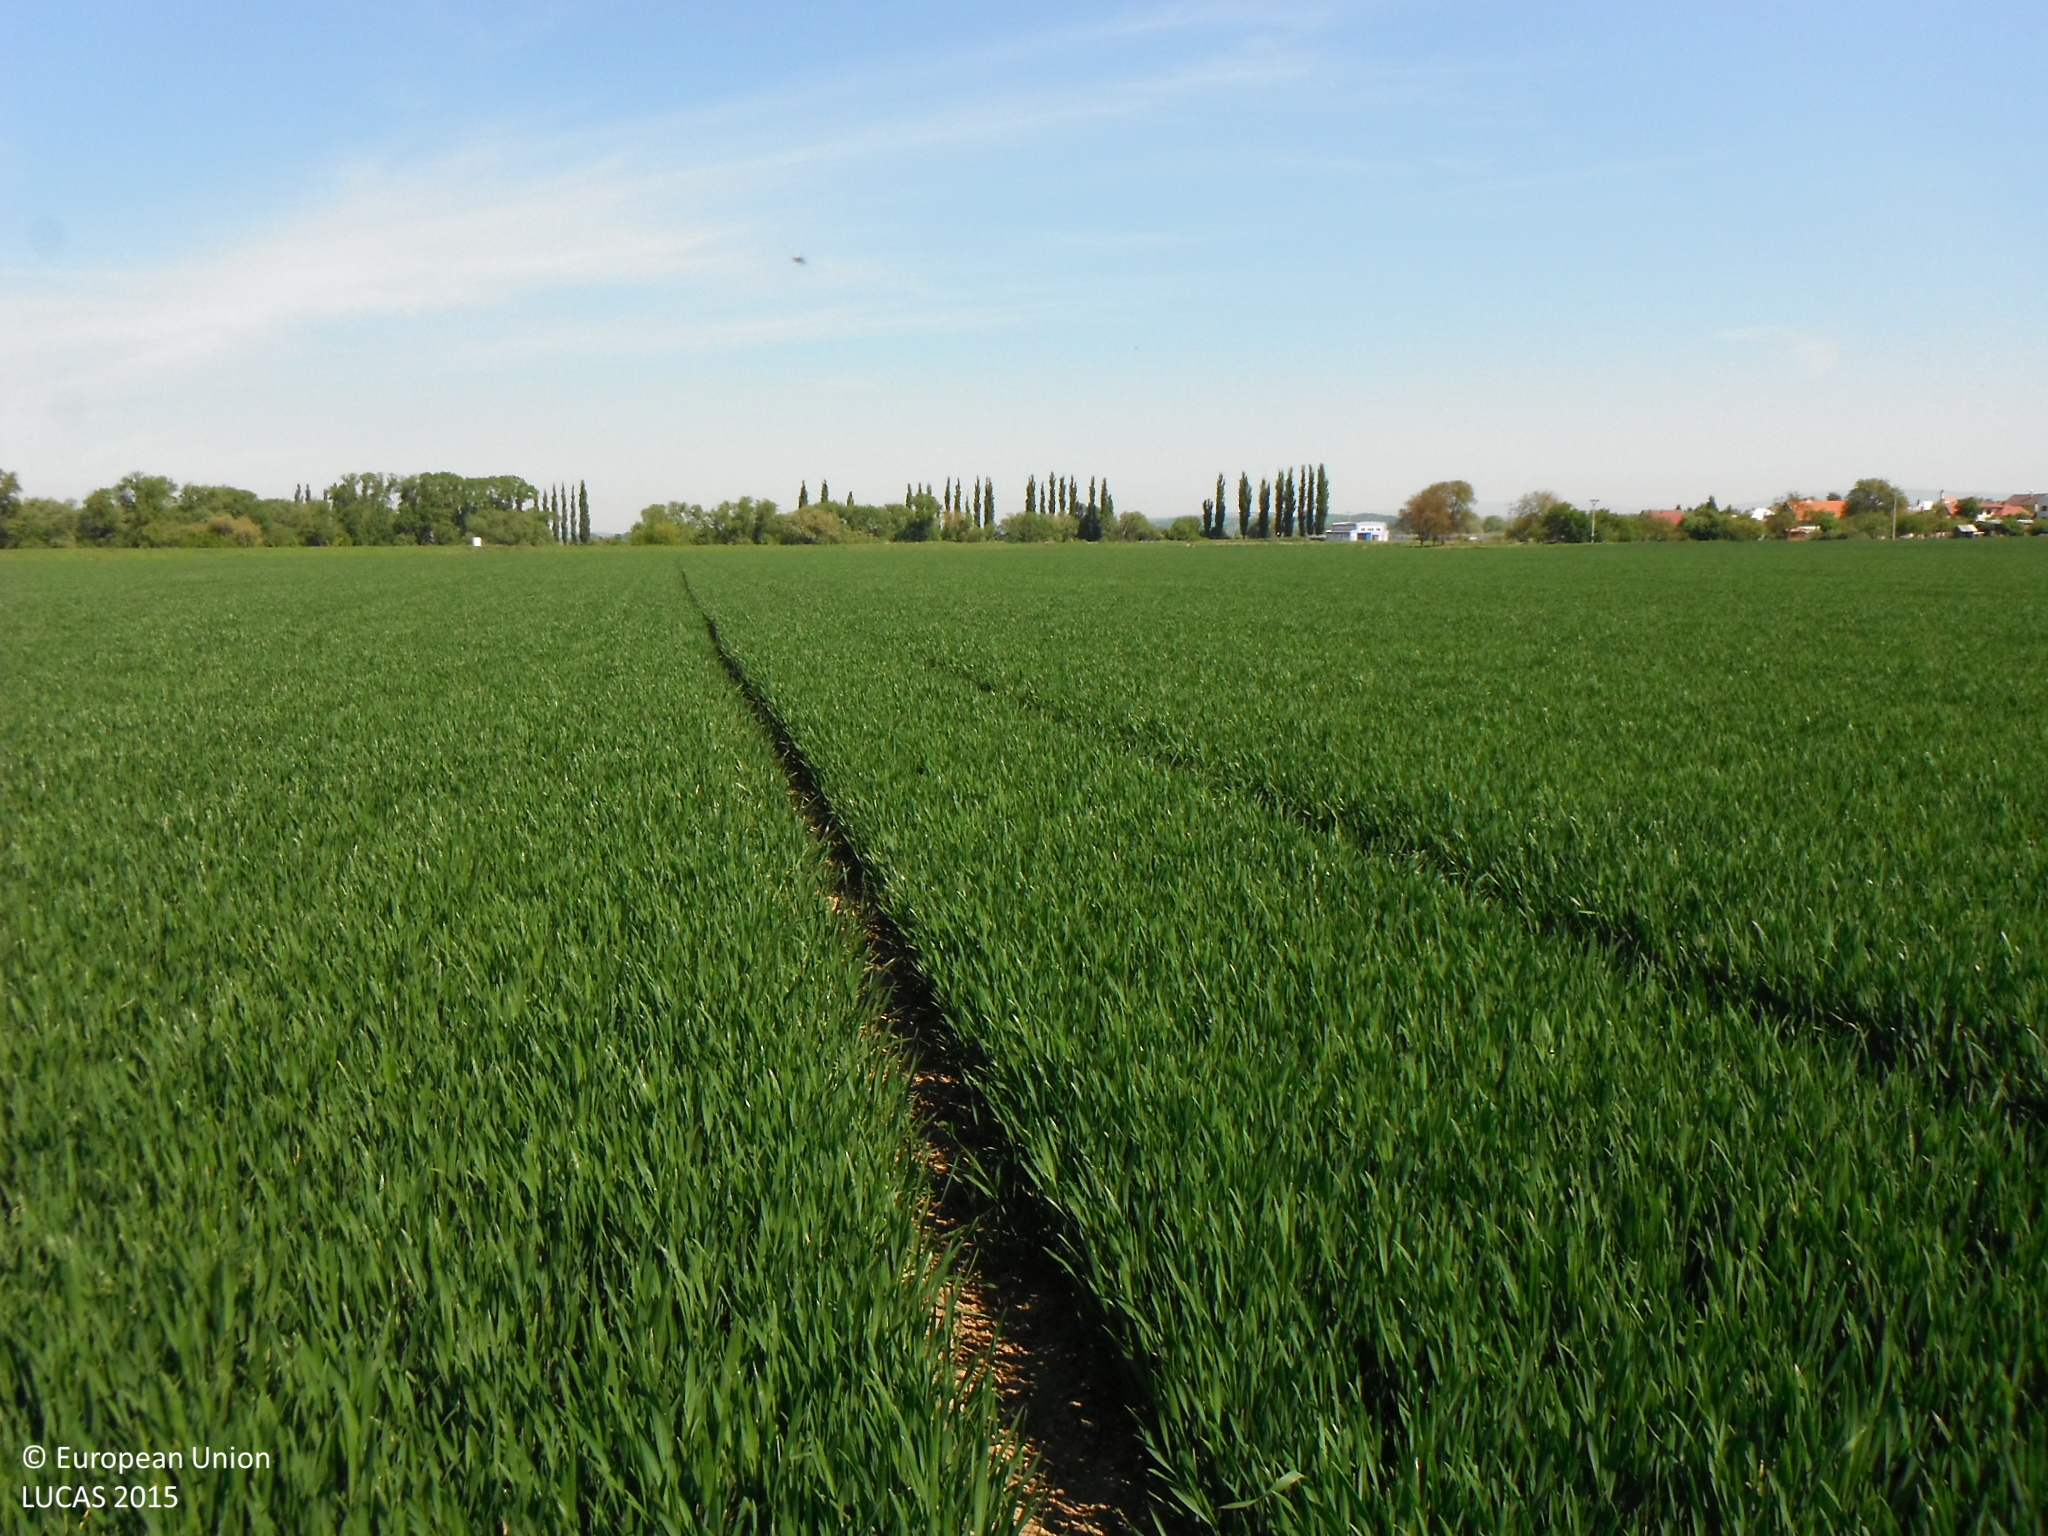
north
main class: Cropland
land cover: Common wheat
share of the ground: > 75 %
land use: Agriculture (excluding fallow land and kitchen gardens)
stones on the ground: < 10 %
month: May
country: SK
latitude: 48.5991
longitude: 21.3409
